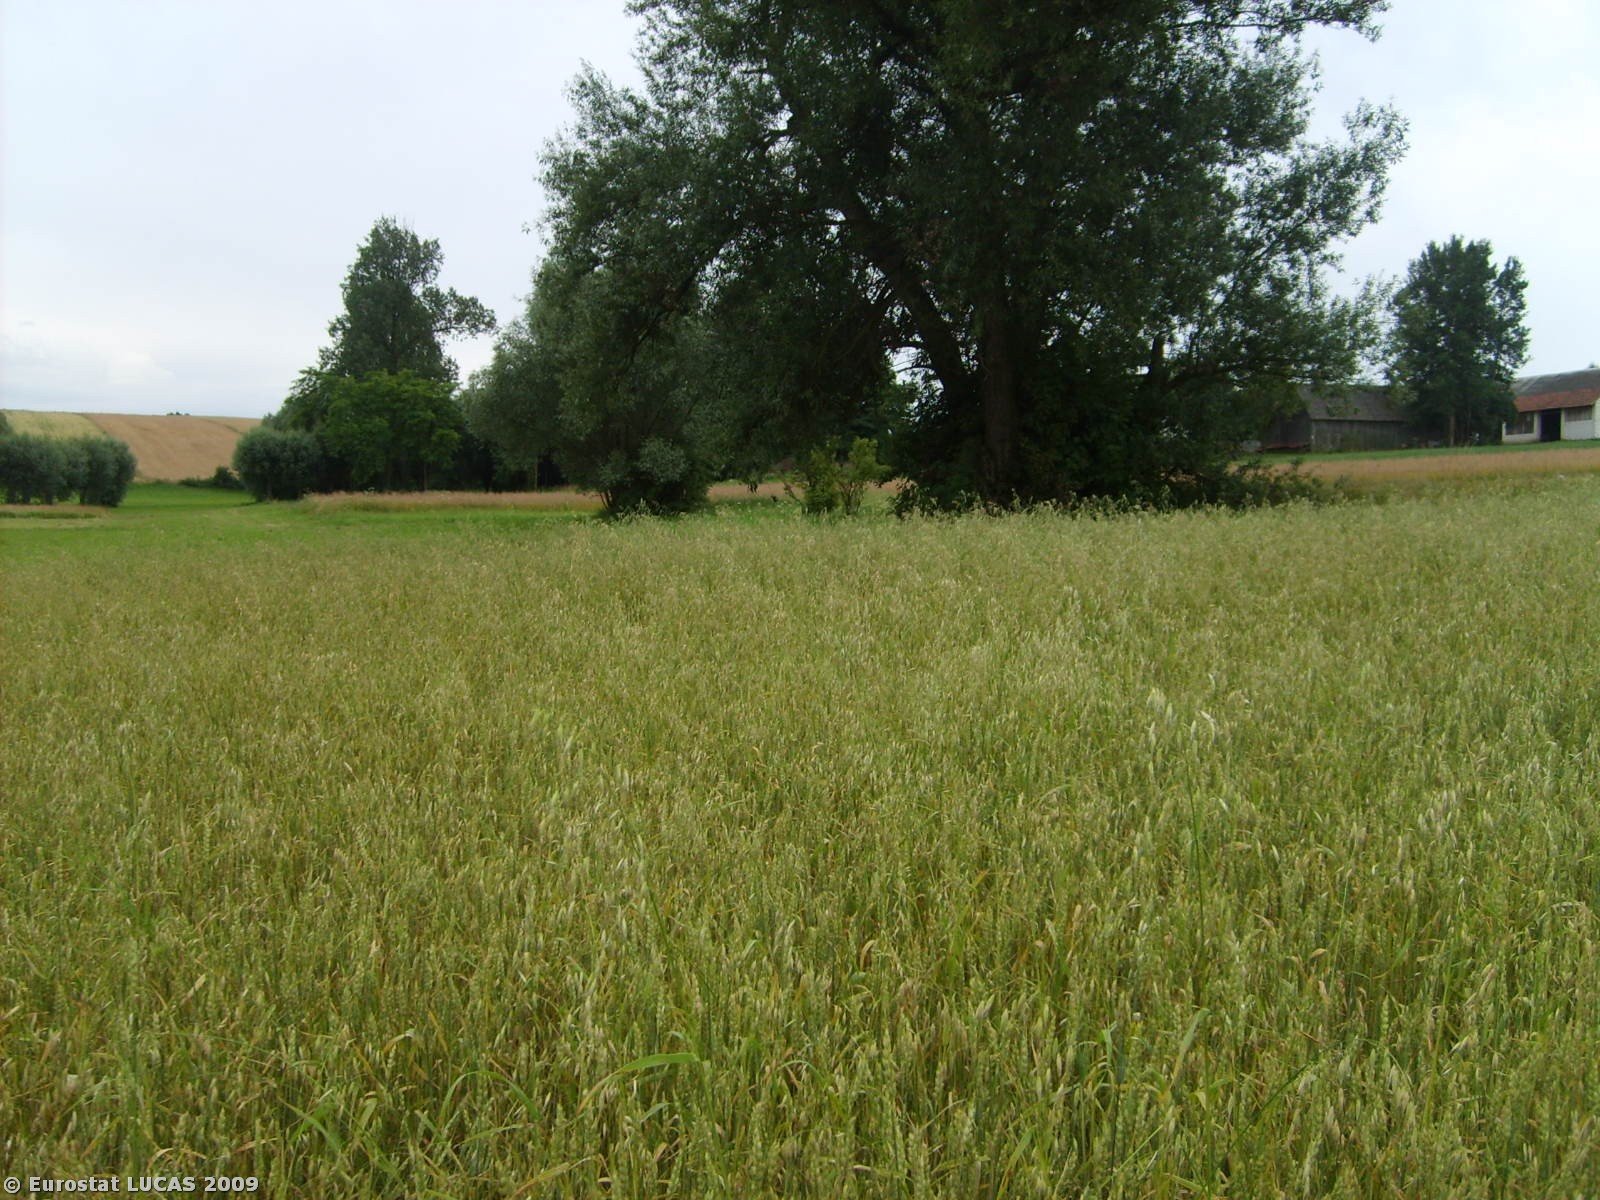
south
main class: Cropland
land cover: Mixed cereals for fodder
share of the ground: > 75 %
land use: Agriculture (excluding fallow land and kitchen gardens)
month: July
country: PL
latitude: 50.3069
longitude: 20.5836
